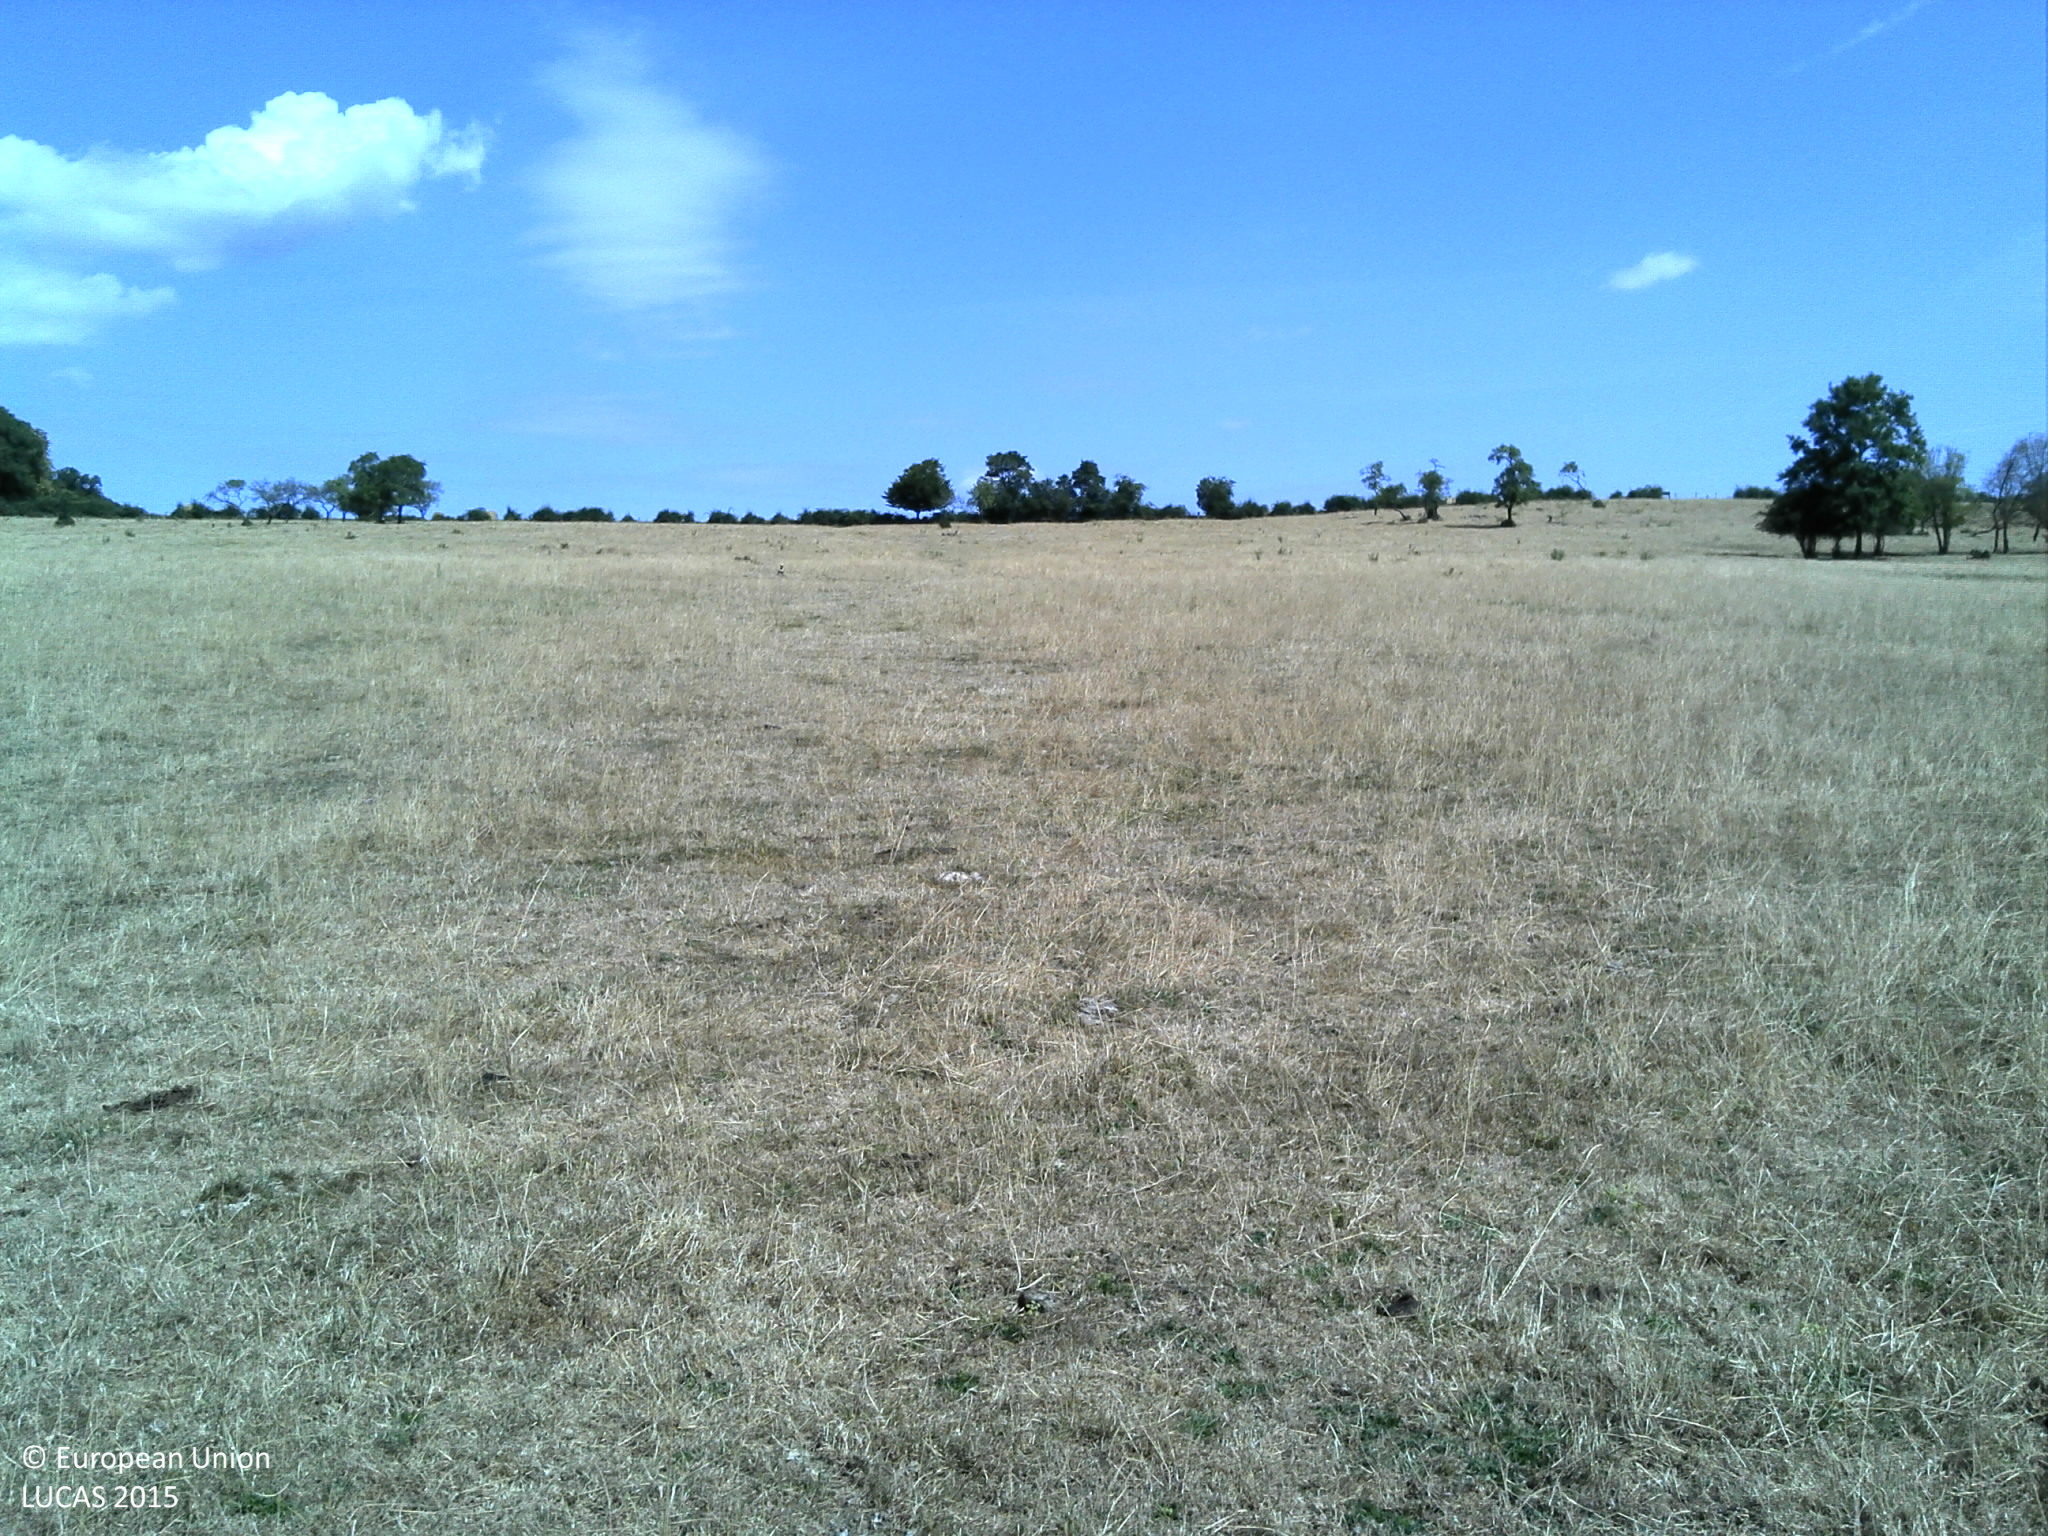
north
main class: Grassland
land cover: Grassland with sparse tree/shrub cover
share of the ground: > 75 %
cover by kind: herbaceous plants 95 %, broadleaved forest trees 5 %
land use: Agriculture (excluding fallow land and kitchen gardens)
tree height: < 5 m
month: July
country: FR
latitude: 48.3329
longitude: 6.0478
